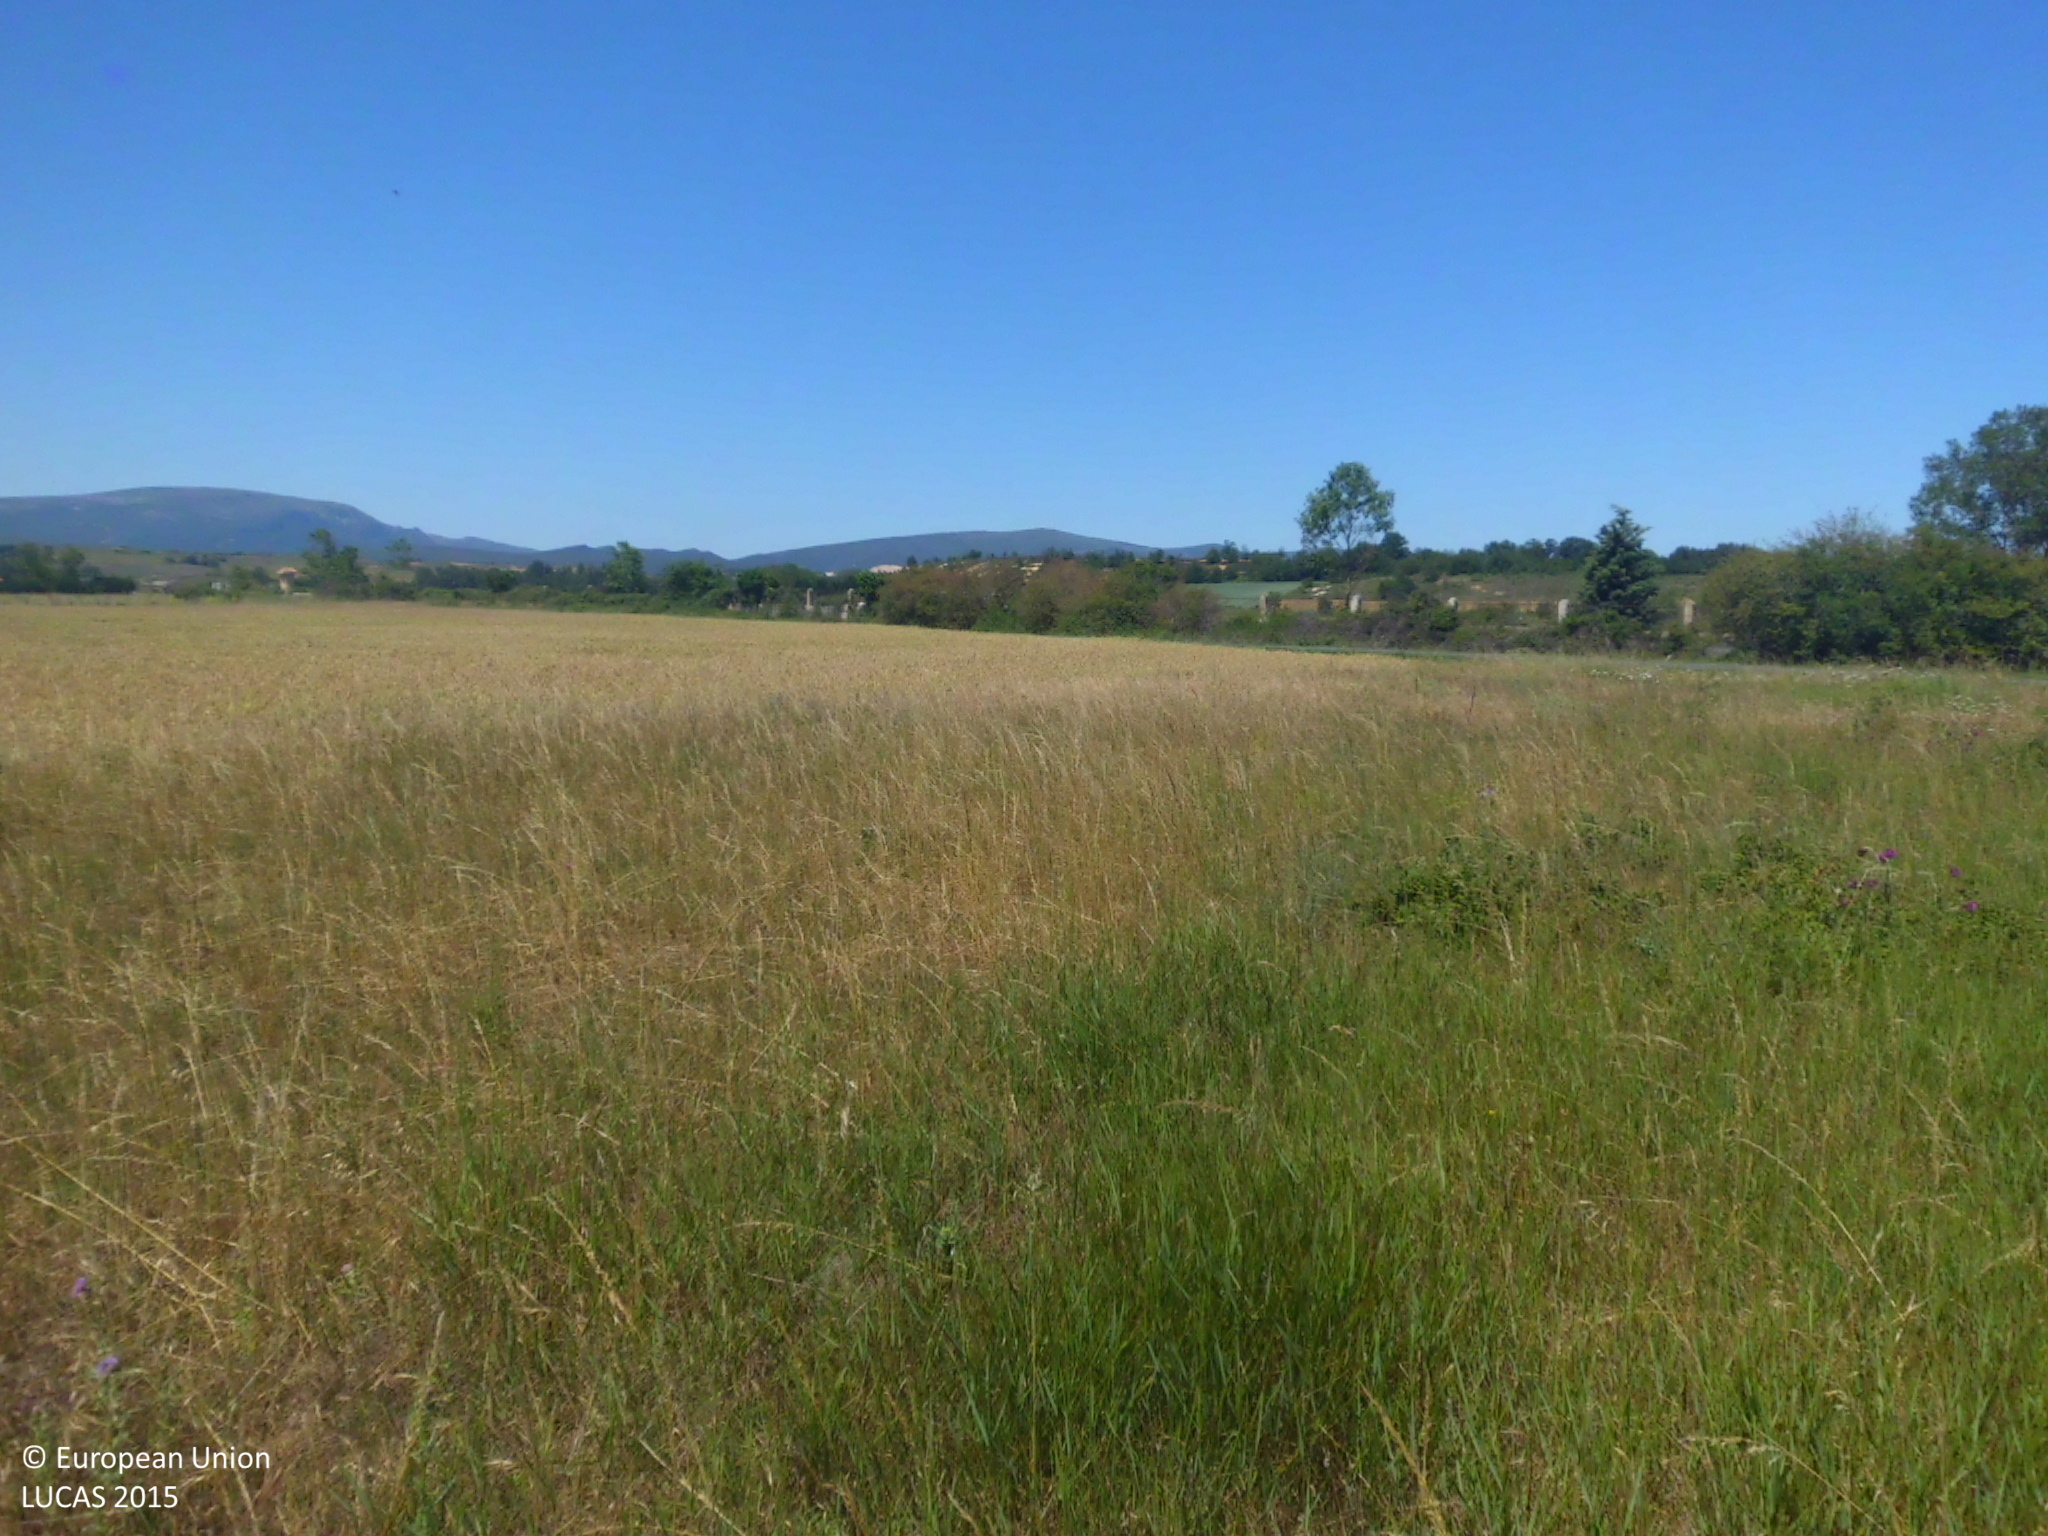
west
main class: Grassland
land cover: Grassland without tree/shrub cover
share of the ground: > 75 %
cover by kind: herbaceous plants 100 %
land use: Agriculture (excluding fallow land and kitchen gardens)
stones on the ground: 25 - 50 %
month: June
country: ES
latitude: 42.9153
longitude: -3.5018
